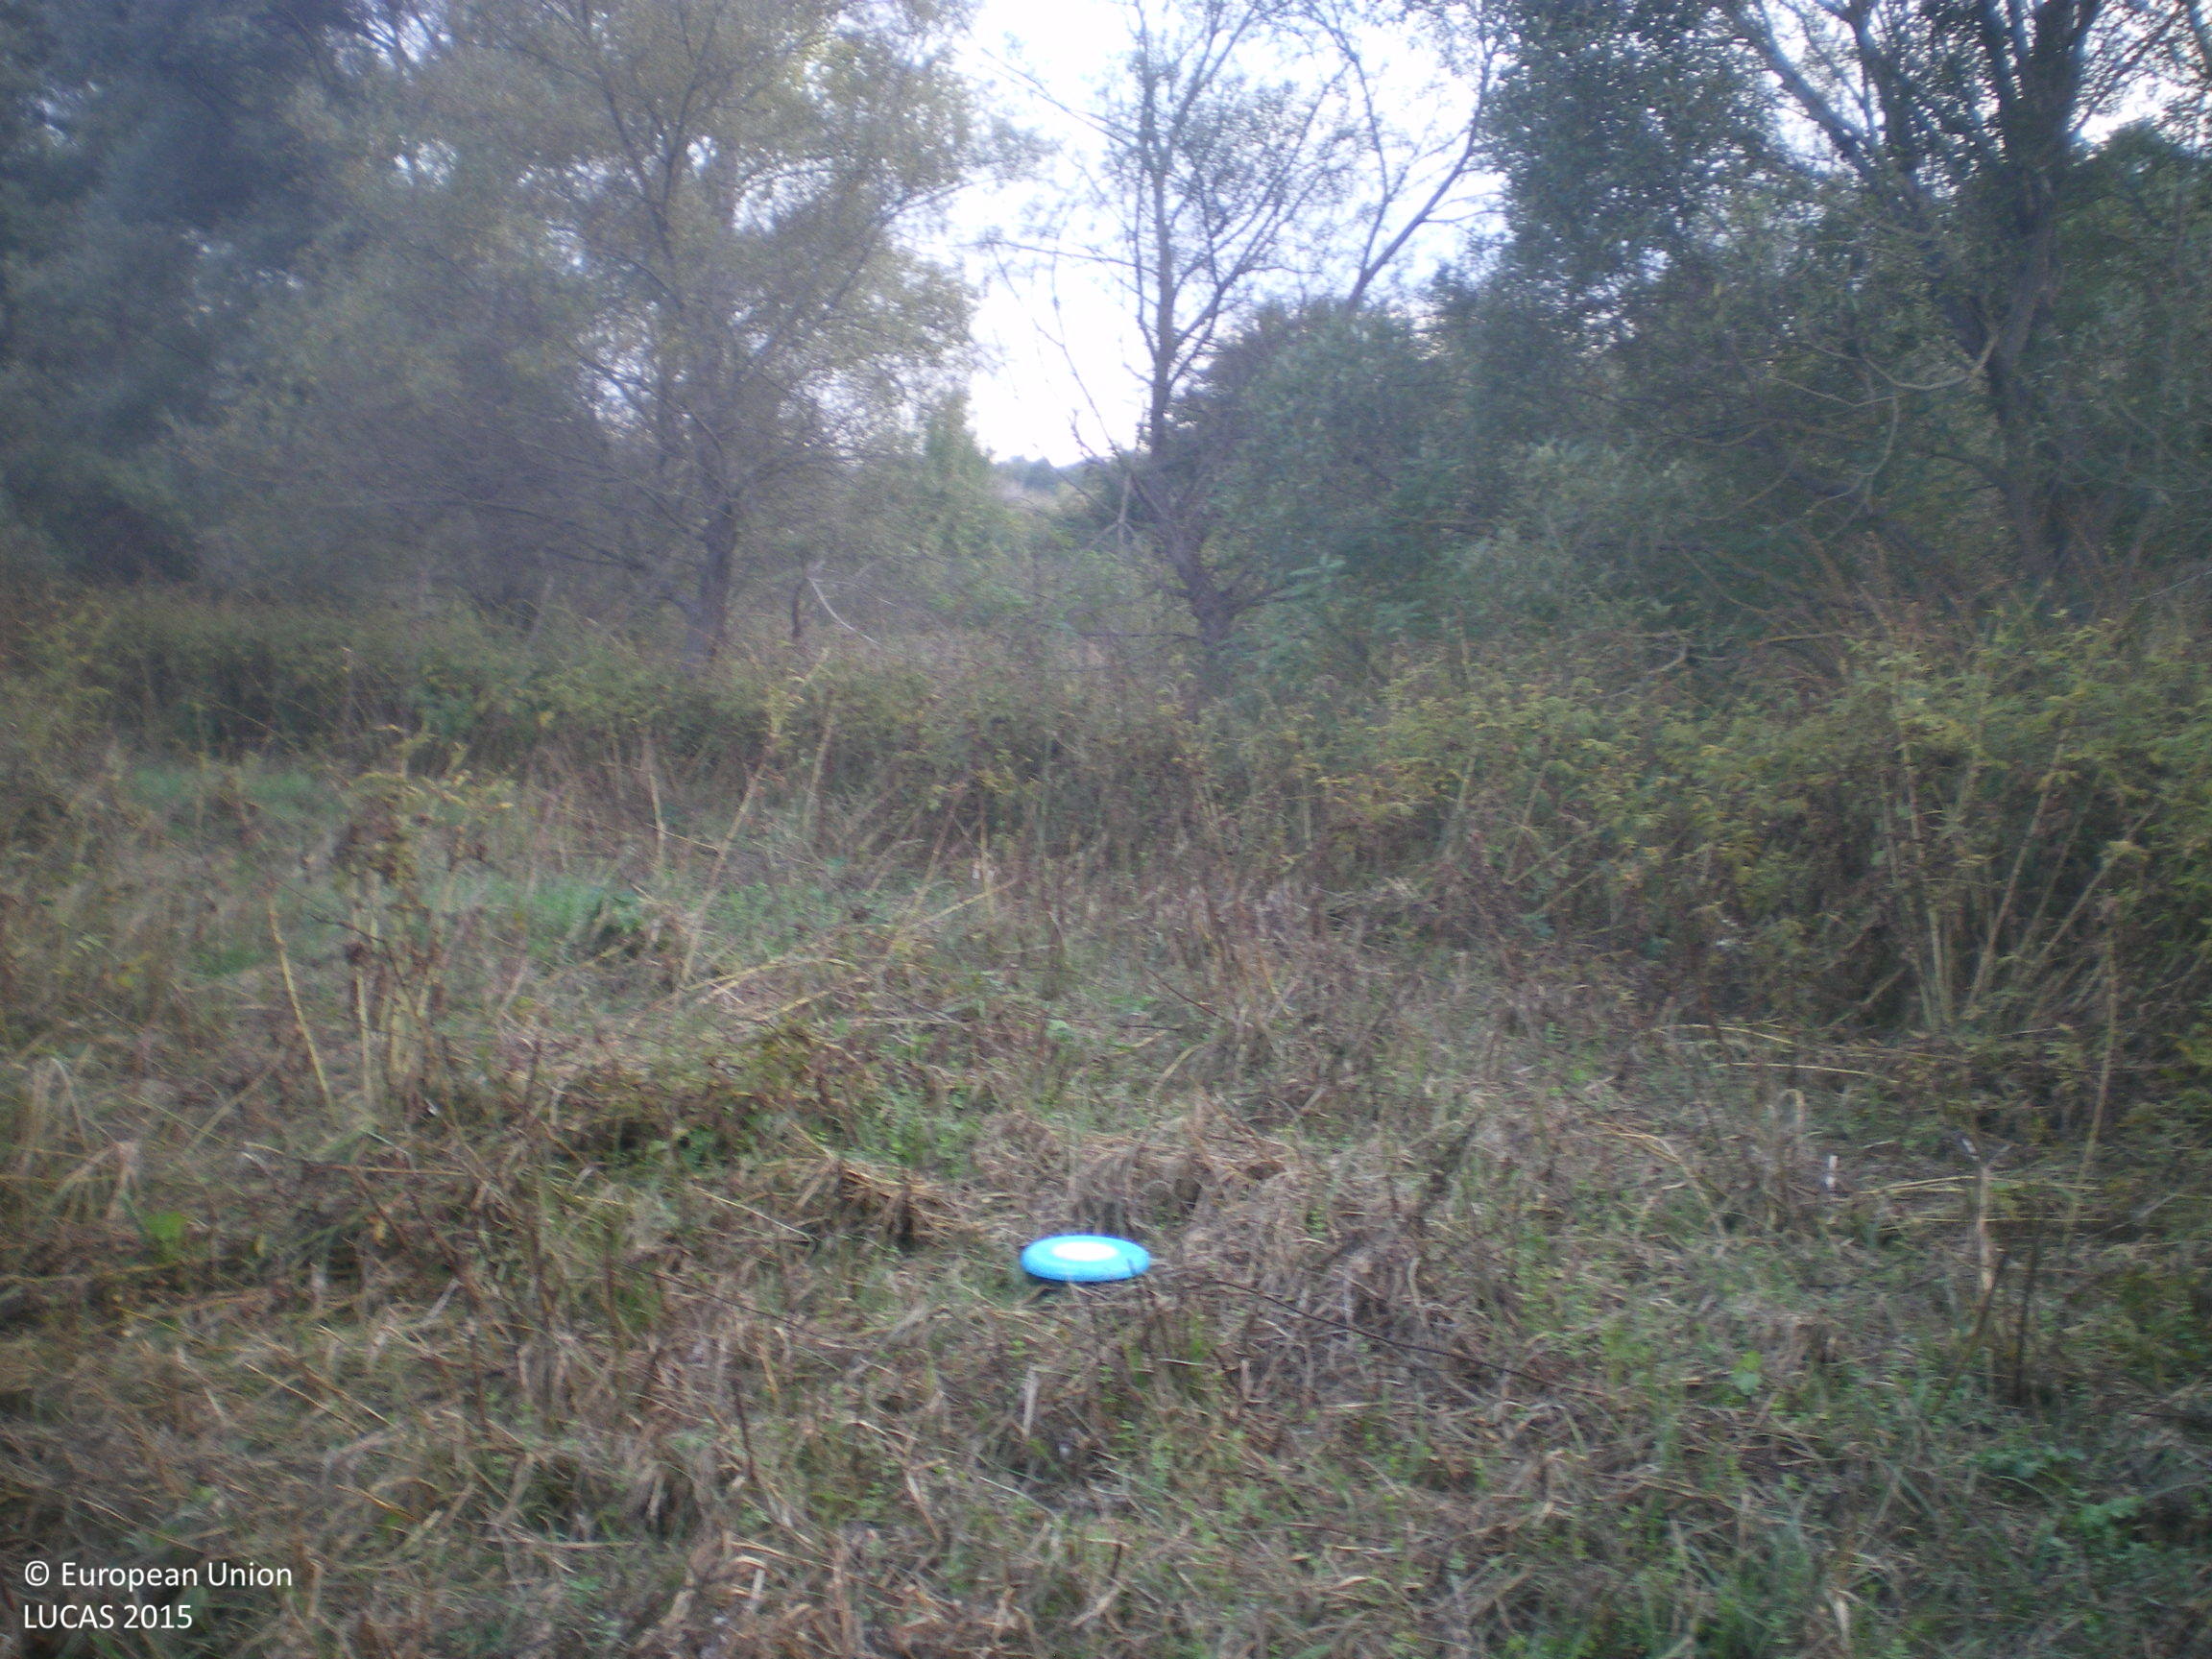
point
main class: Grassland
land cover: Grassland with sparse tree/shrub cover
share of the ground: > 75 %
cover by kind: herbaceous plants 90 %, broadleaved forest trees 5 %, shrubs 5 %
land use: Agriculture (excluding fallow land and kitchen gardens)
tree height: > 5 m
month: October
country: BG
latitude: 42.0901
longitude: 26.2205
